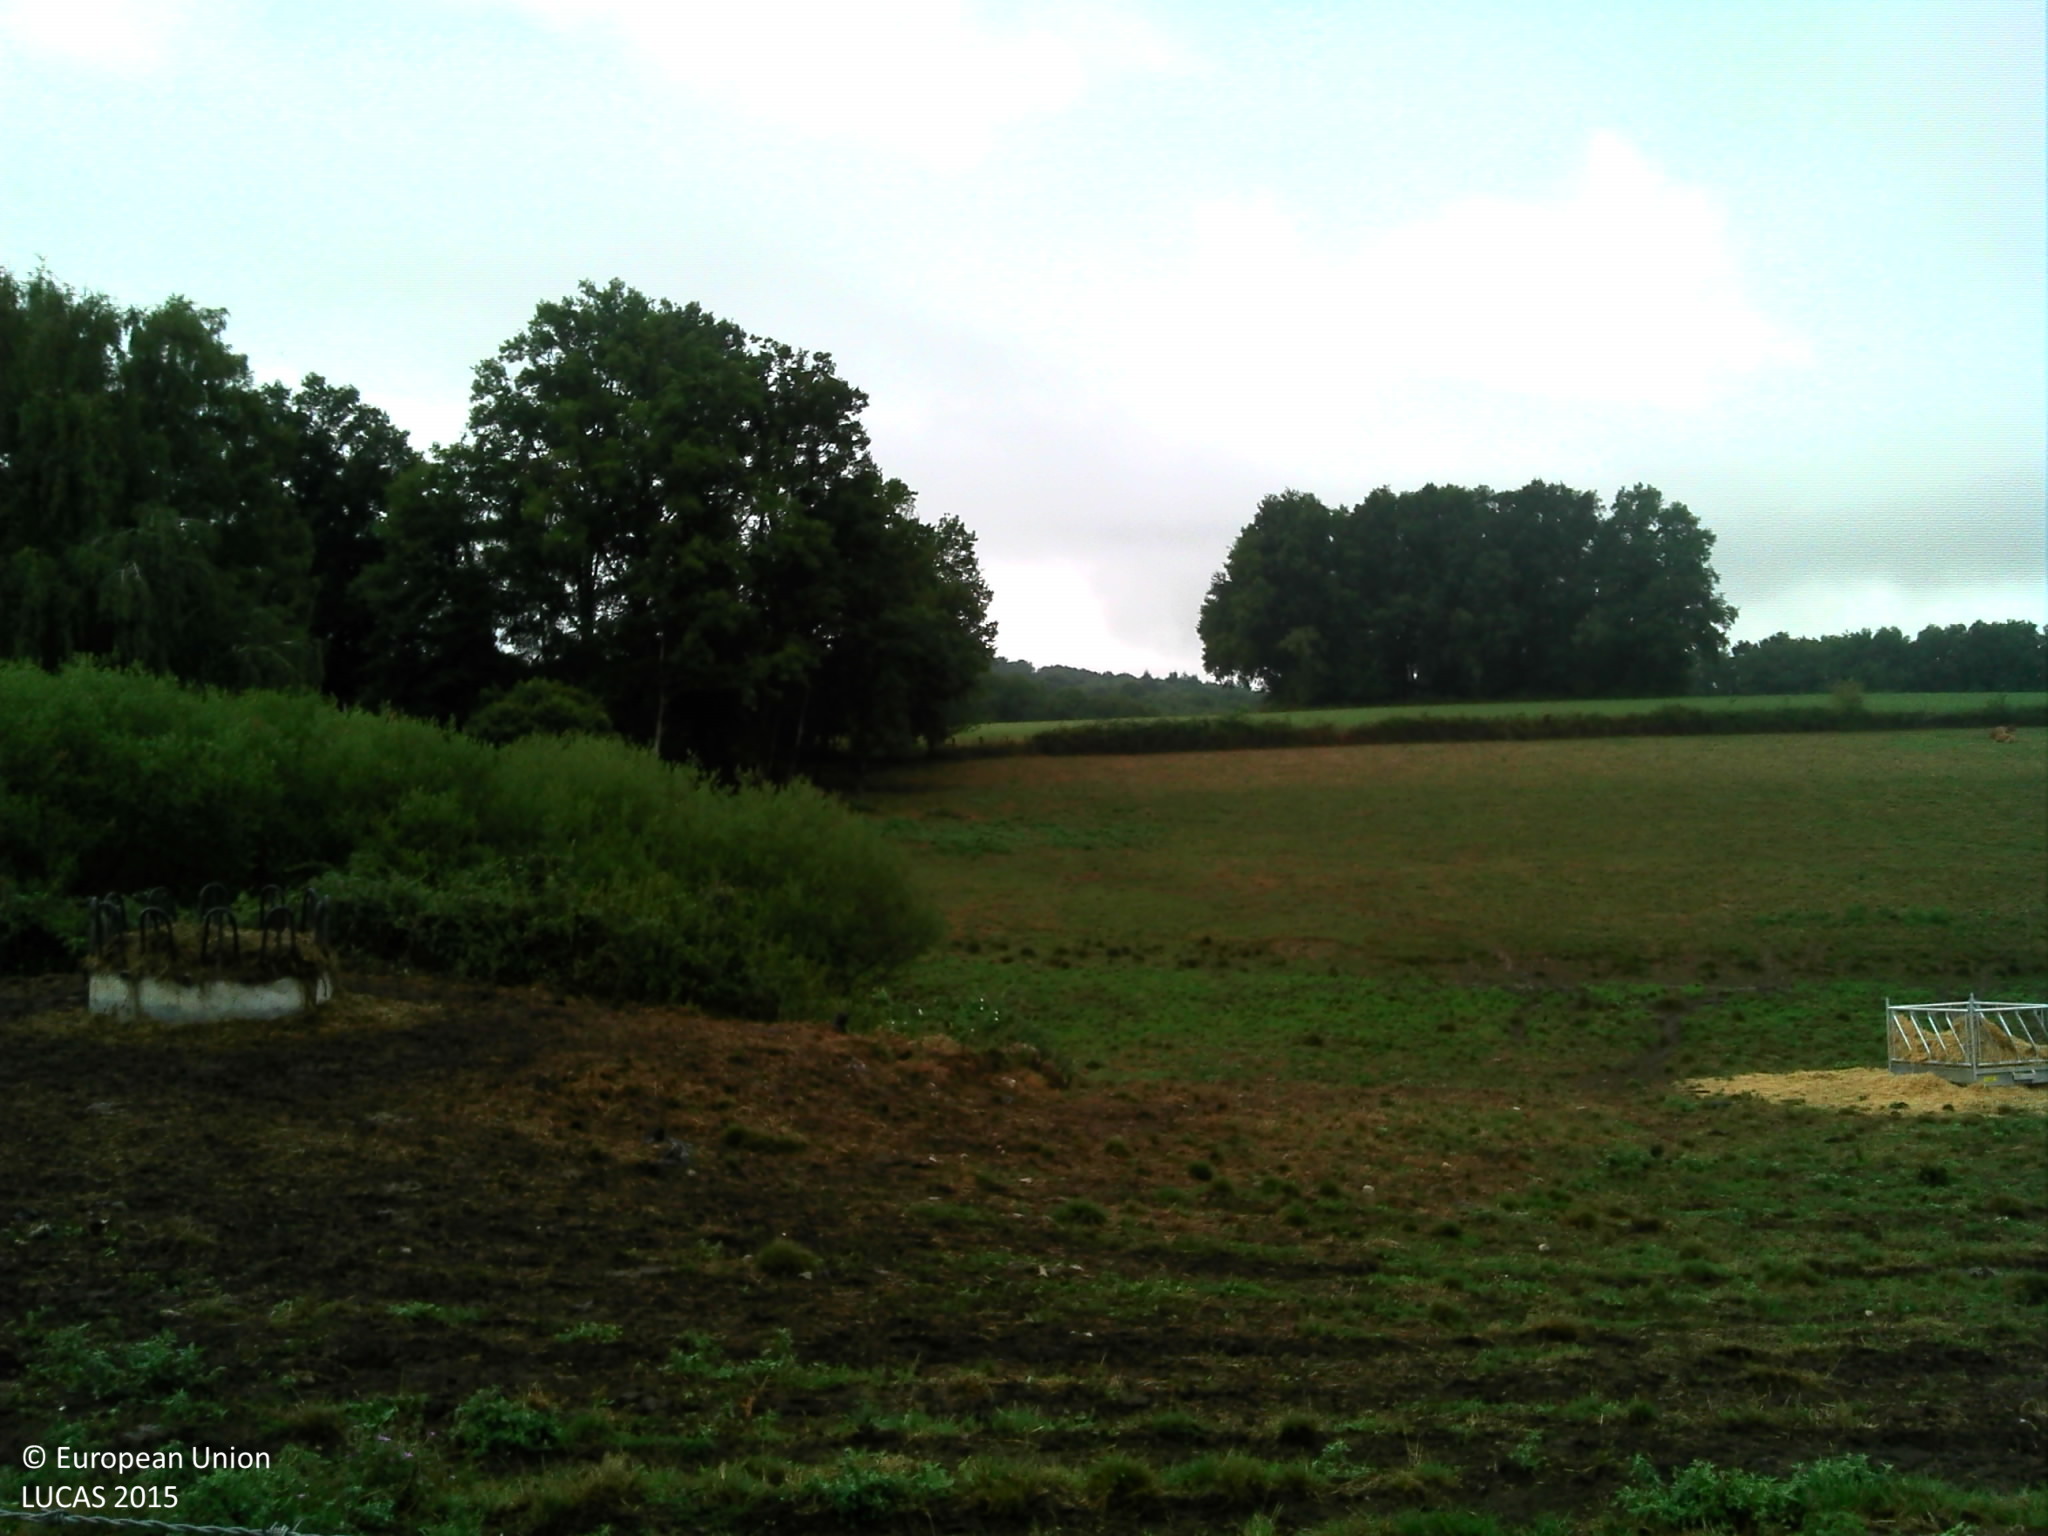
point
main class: Cropland
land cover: Temporary grasslands
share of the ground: > 75 %
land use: Agriculture (excluding fallow land and kitchen gardens)
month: August
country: FR
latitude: 45.5195
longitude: 1.0163
